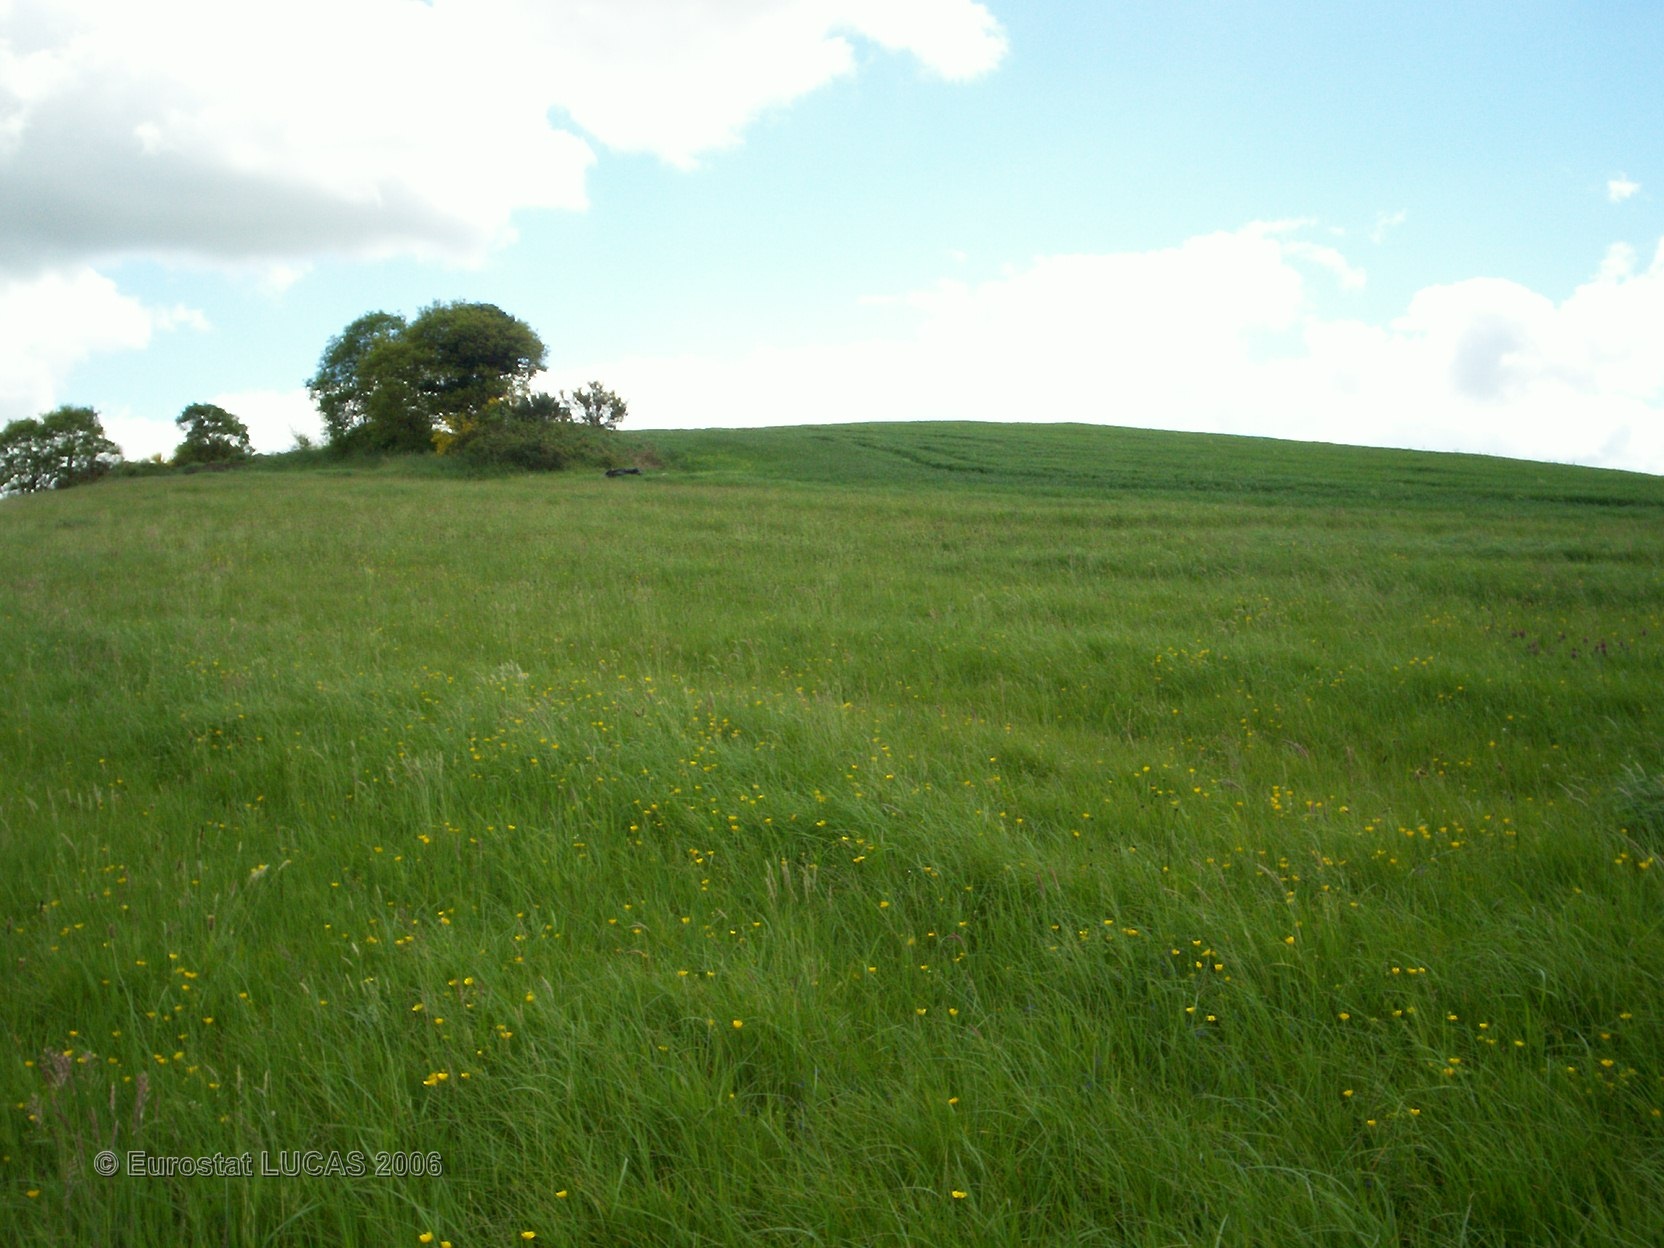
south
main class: Grassland
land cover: Grassland without tree/shrub cover
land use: Agriculture (excluding fallow land and kitchen gardens)
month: May
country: FR
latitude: 48.4125
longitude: -3.0266
